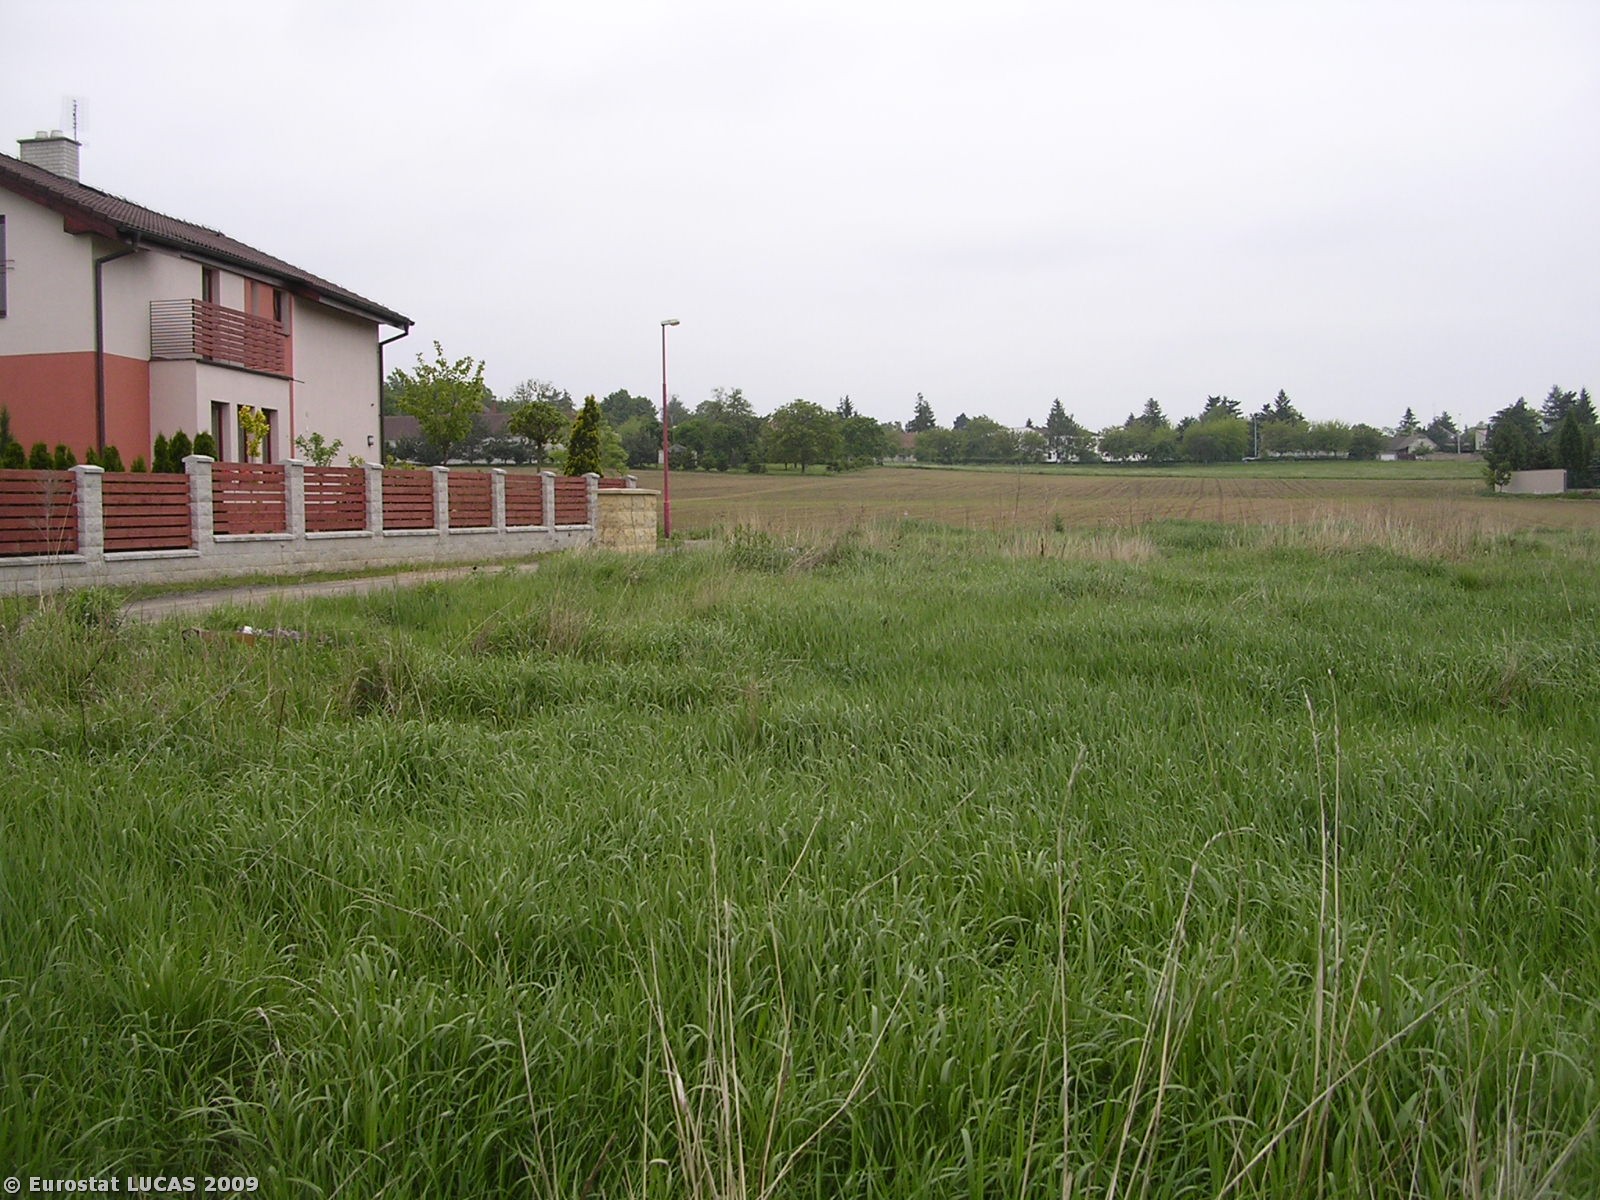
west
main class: Grassland
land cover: Grassland without tree/shrub cover
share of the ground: > 75 %
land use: Fallow land
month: May
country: CZ
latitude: 50.1060
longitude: 14.6860
